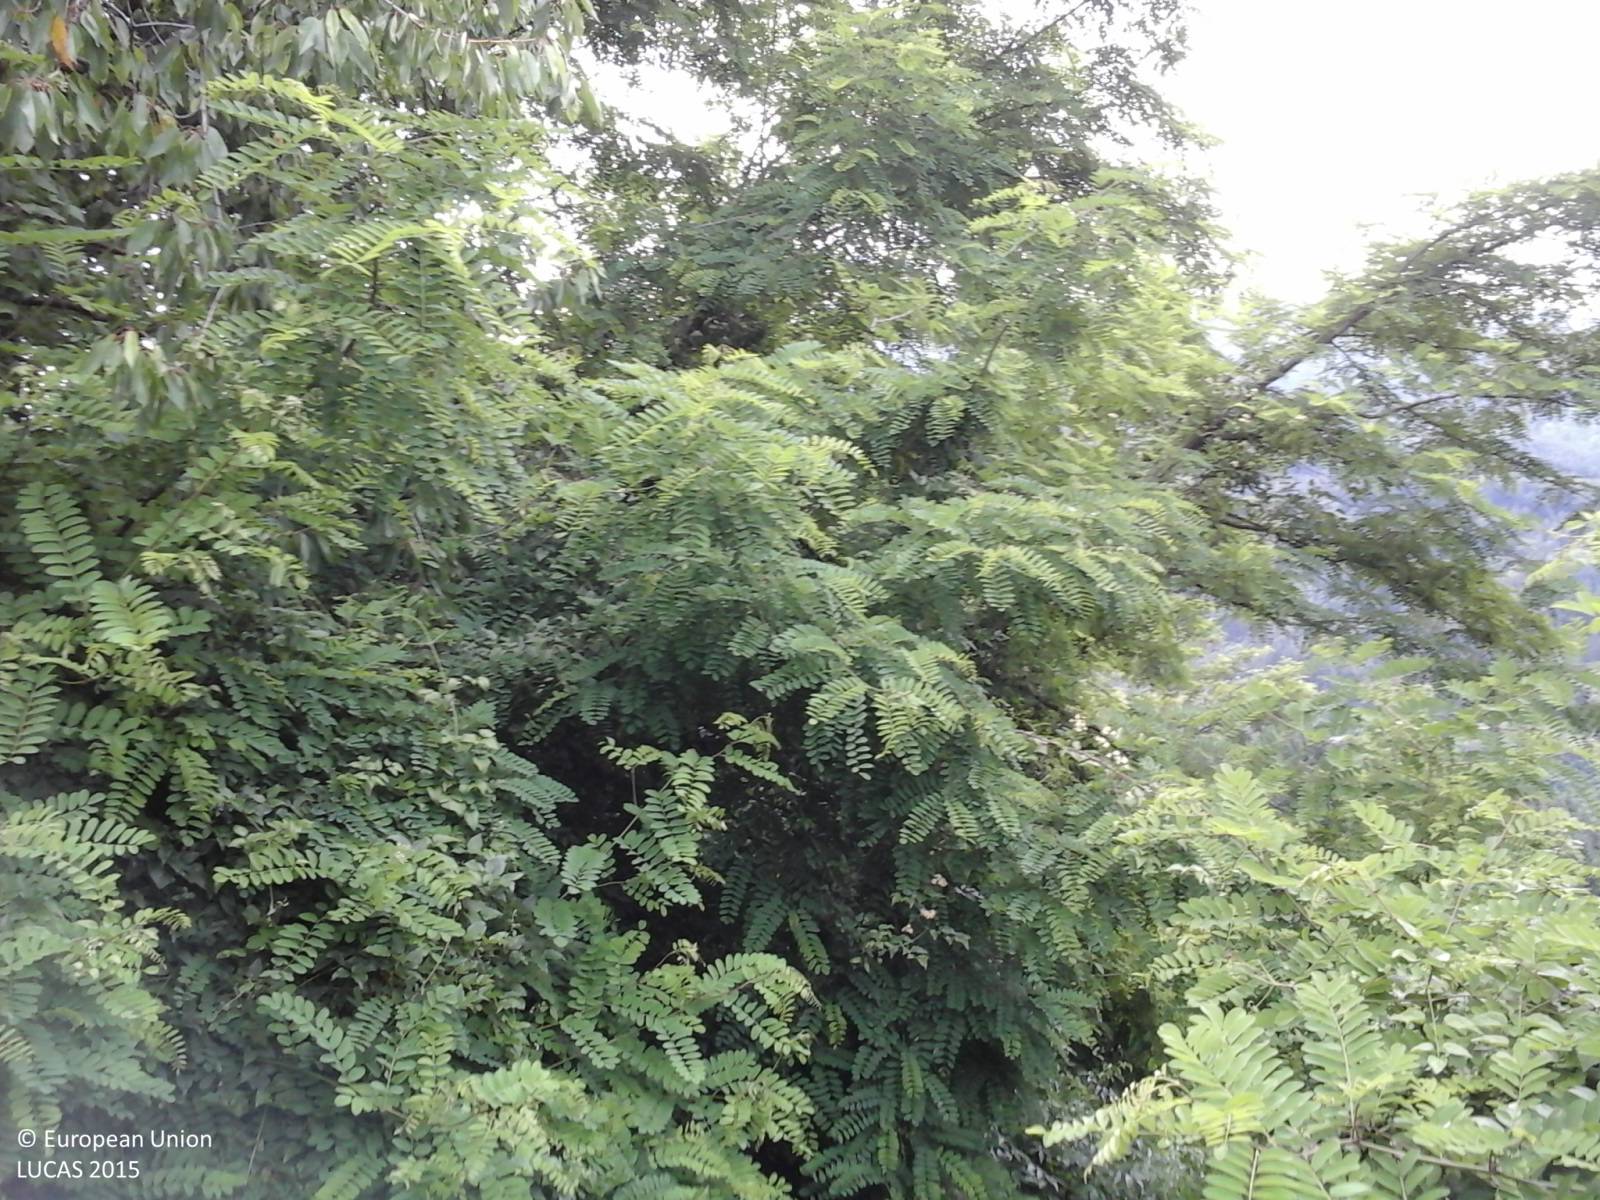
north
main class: Woodland
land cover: Broadleaved woodland
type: thermophilous deciduous forest
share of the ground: > 75 %
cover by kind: broadleaved forest trees 100 %
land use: Semi-natural and natural areas not in use
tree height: > 5 m
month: June
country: IT
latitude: 44.1697
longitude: 10.3119
